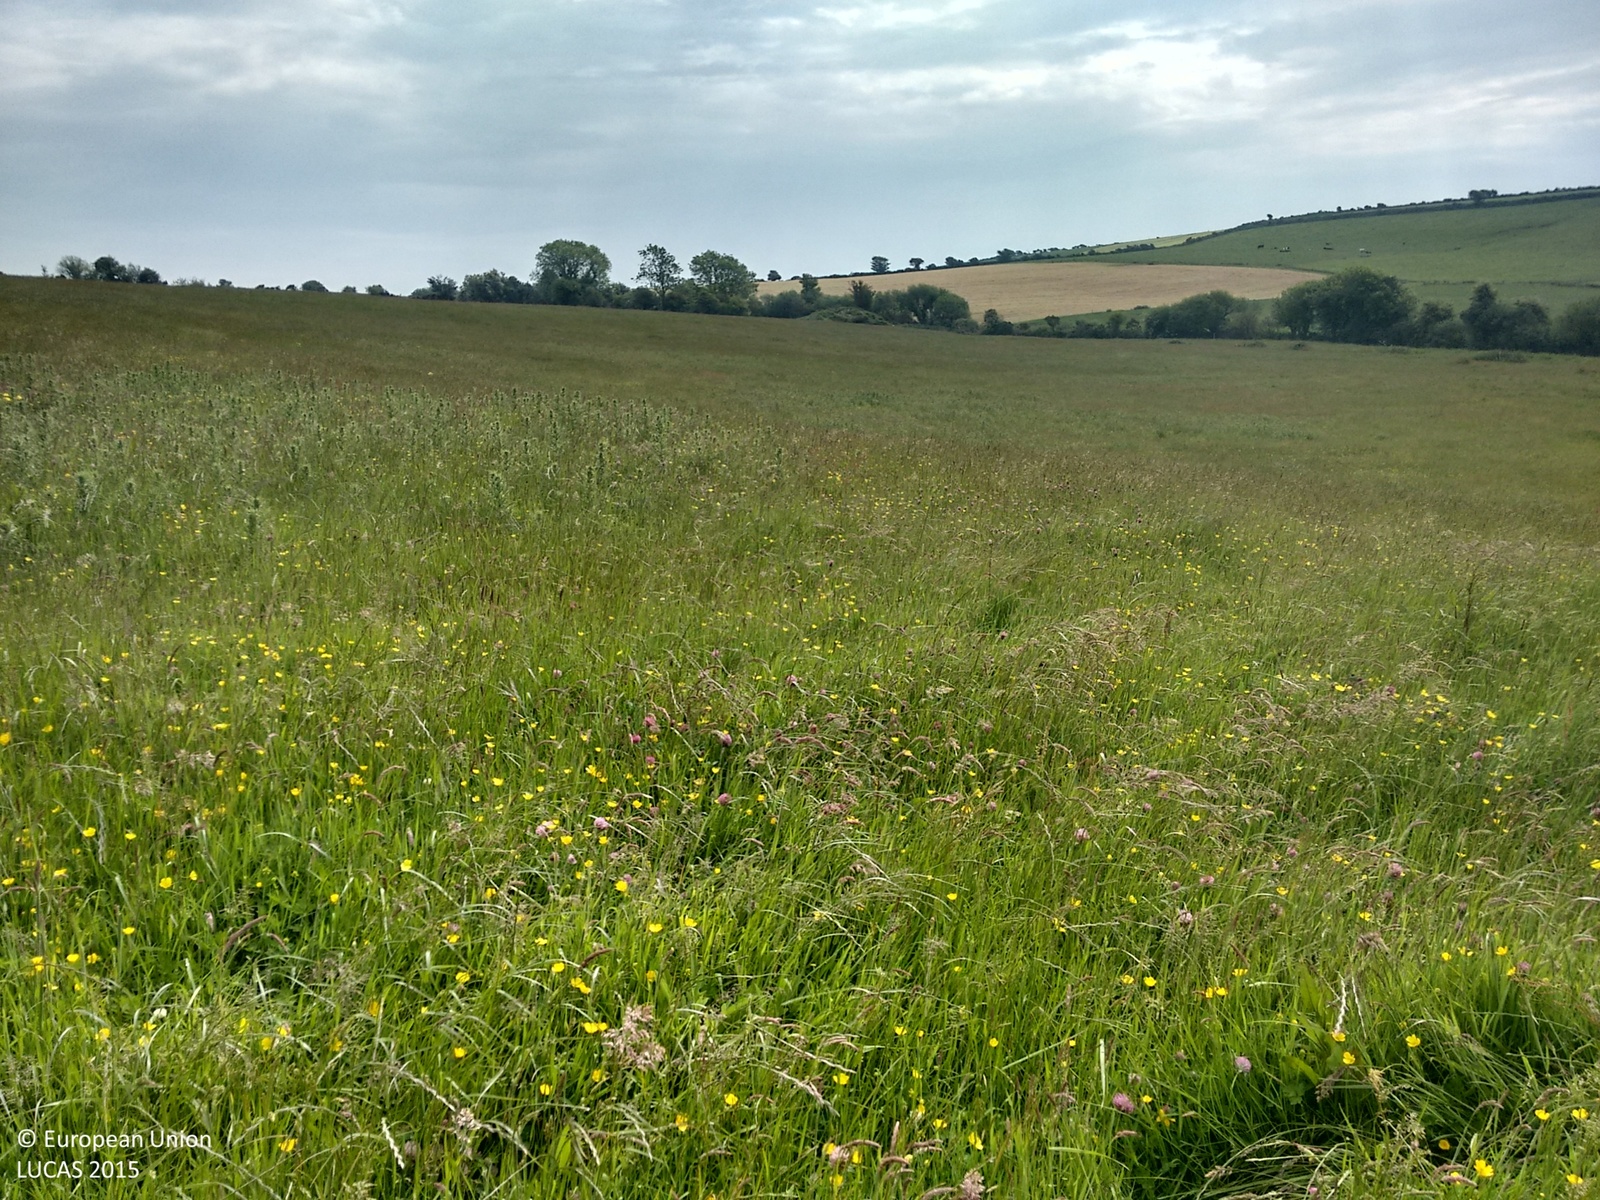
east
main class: Grassland
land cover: Grassland without tree/shrub cover
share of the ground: > 75 %
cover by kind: herbaceous plants 100 %
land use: Agriculture (excluding fallow land and kitchen gardens)
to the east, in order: Grassland without tree/shrub cover; Broadleaved woodland
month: June
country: IE
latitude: 51.6581
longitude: -8.7499
